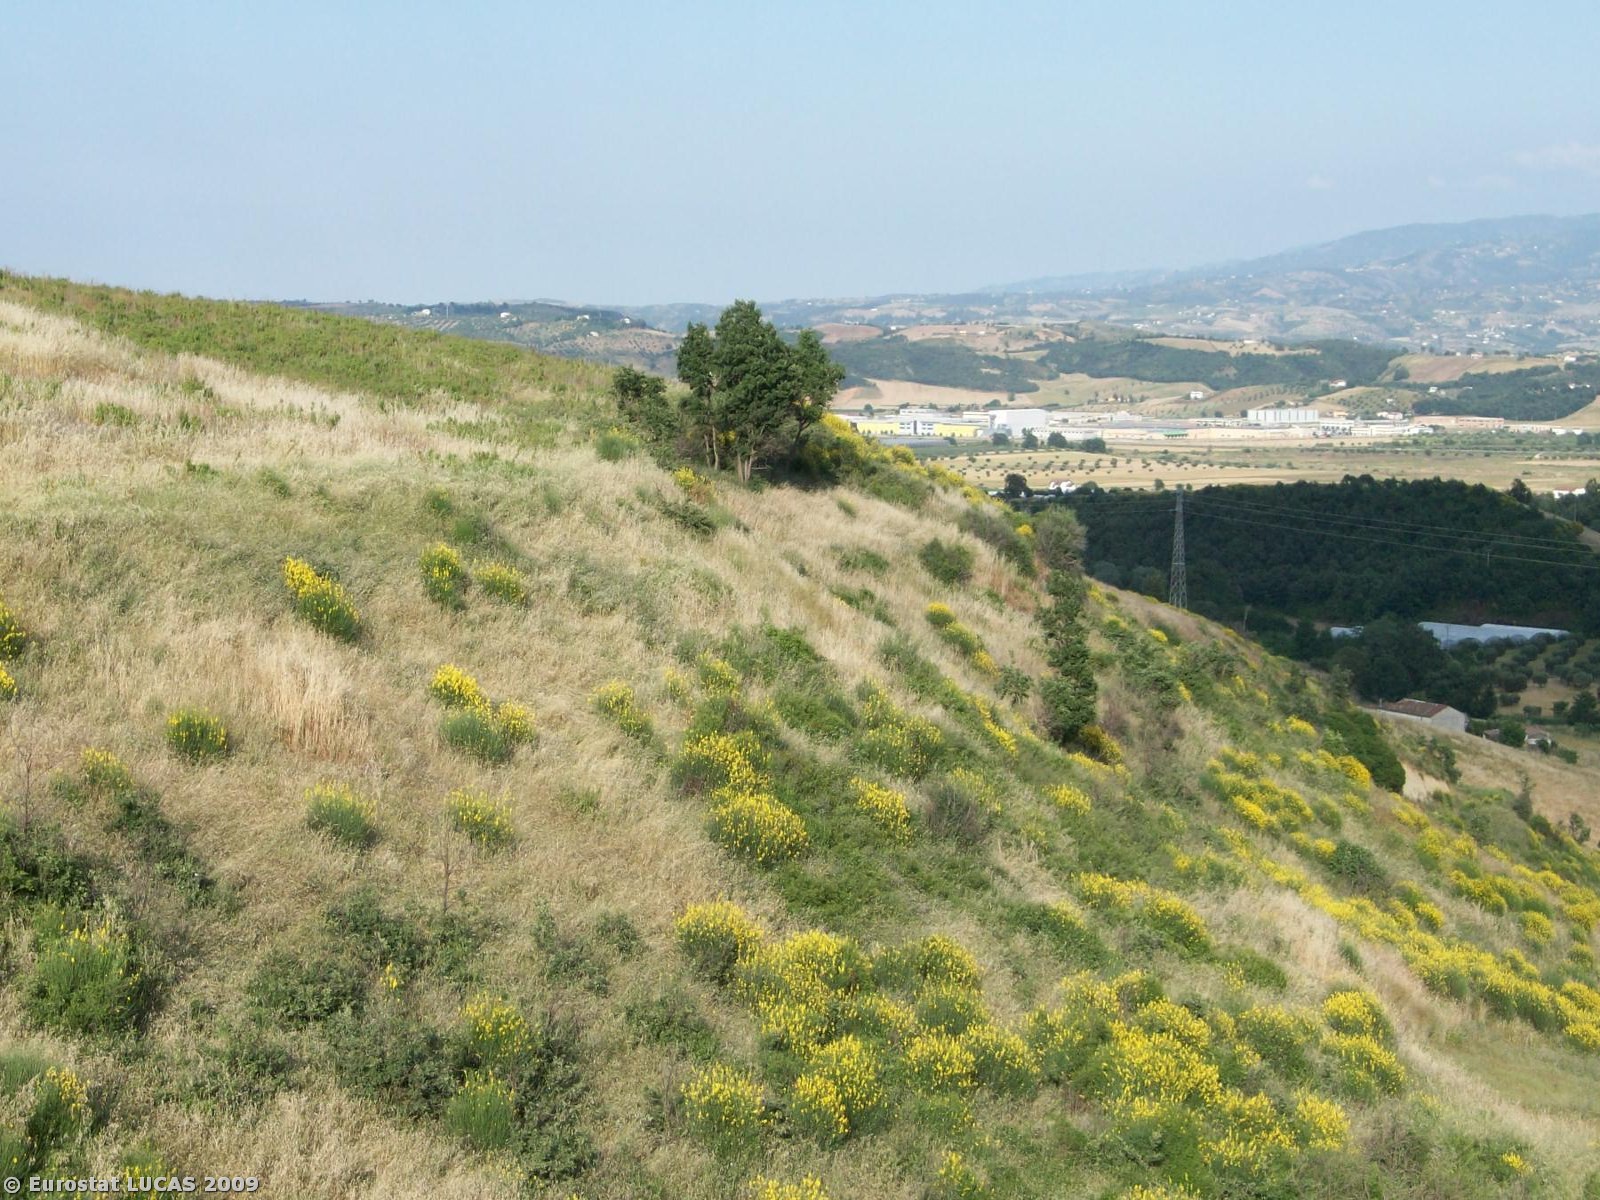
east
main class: Grassland
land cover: Spontaneously vegetated surfaces
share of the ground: > 75 %
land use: Fallow land
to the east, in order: Spontaneously vegetated surfaces; Shrubland with sparse tree cover
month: May
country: IT
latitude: 39.6020
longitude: 16.1554
